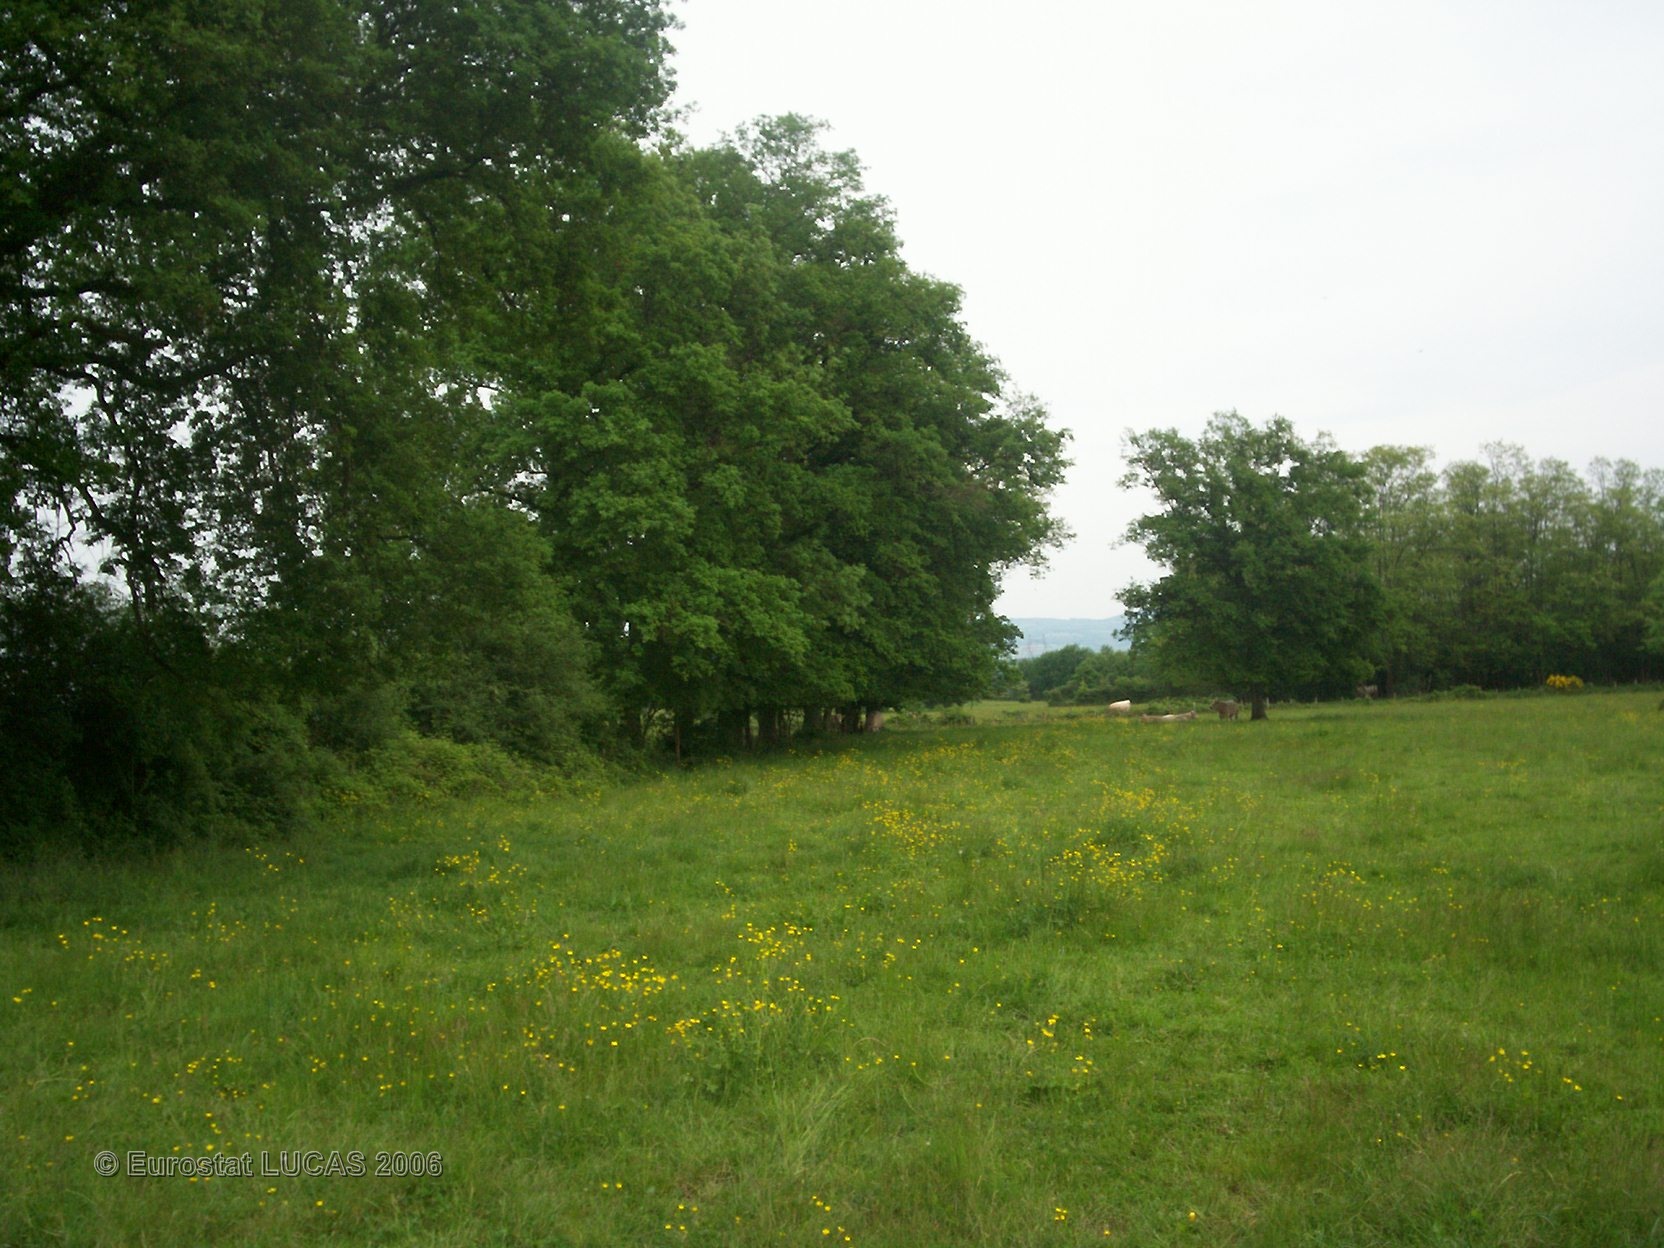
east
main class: Grassland
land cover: Grassland with sparse tree/shrub cover
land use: Agriculture (excluding fallow land and kitchen gardens)
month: May
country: FR
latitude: 46.6355
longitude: 4.7110
